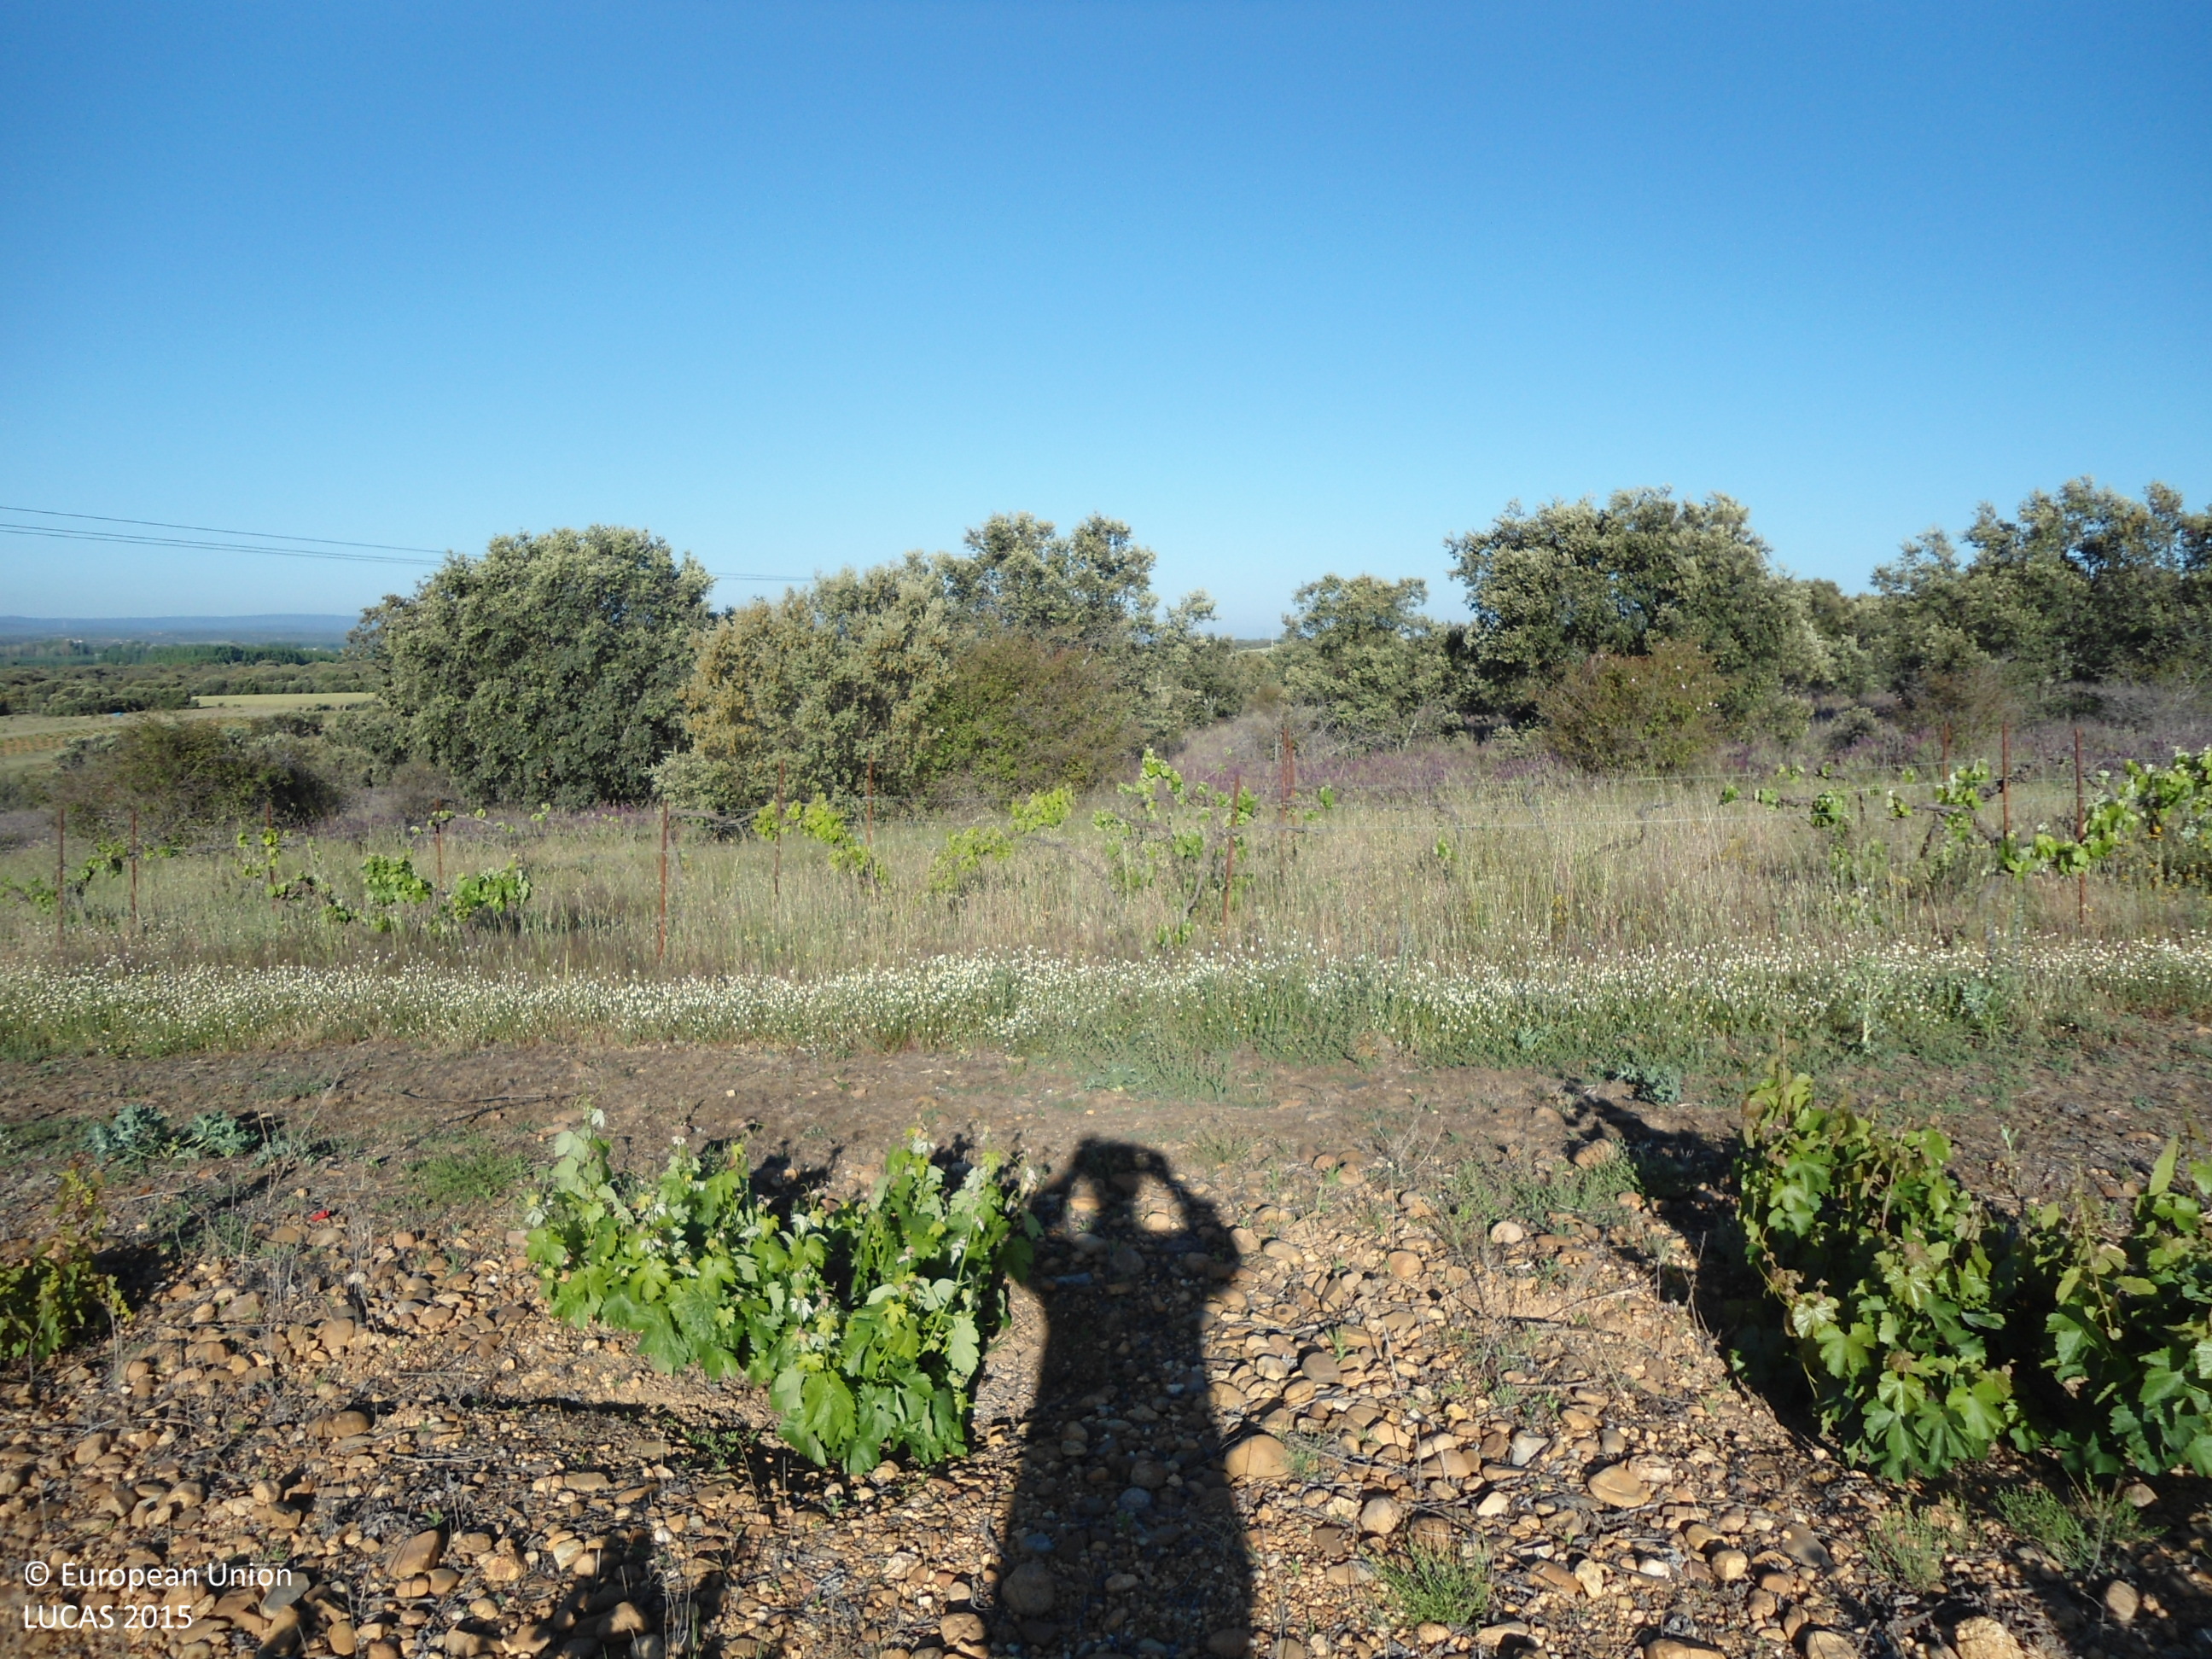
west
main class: Cropland
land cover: Vineyards
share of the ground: 25 - 50 %
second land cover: Other bare soil
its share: > 75 %
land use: Agriculture (excluding fallow land and kitchen gardens)
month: May
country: ES
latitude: 42.0090
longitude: -5.9268
